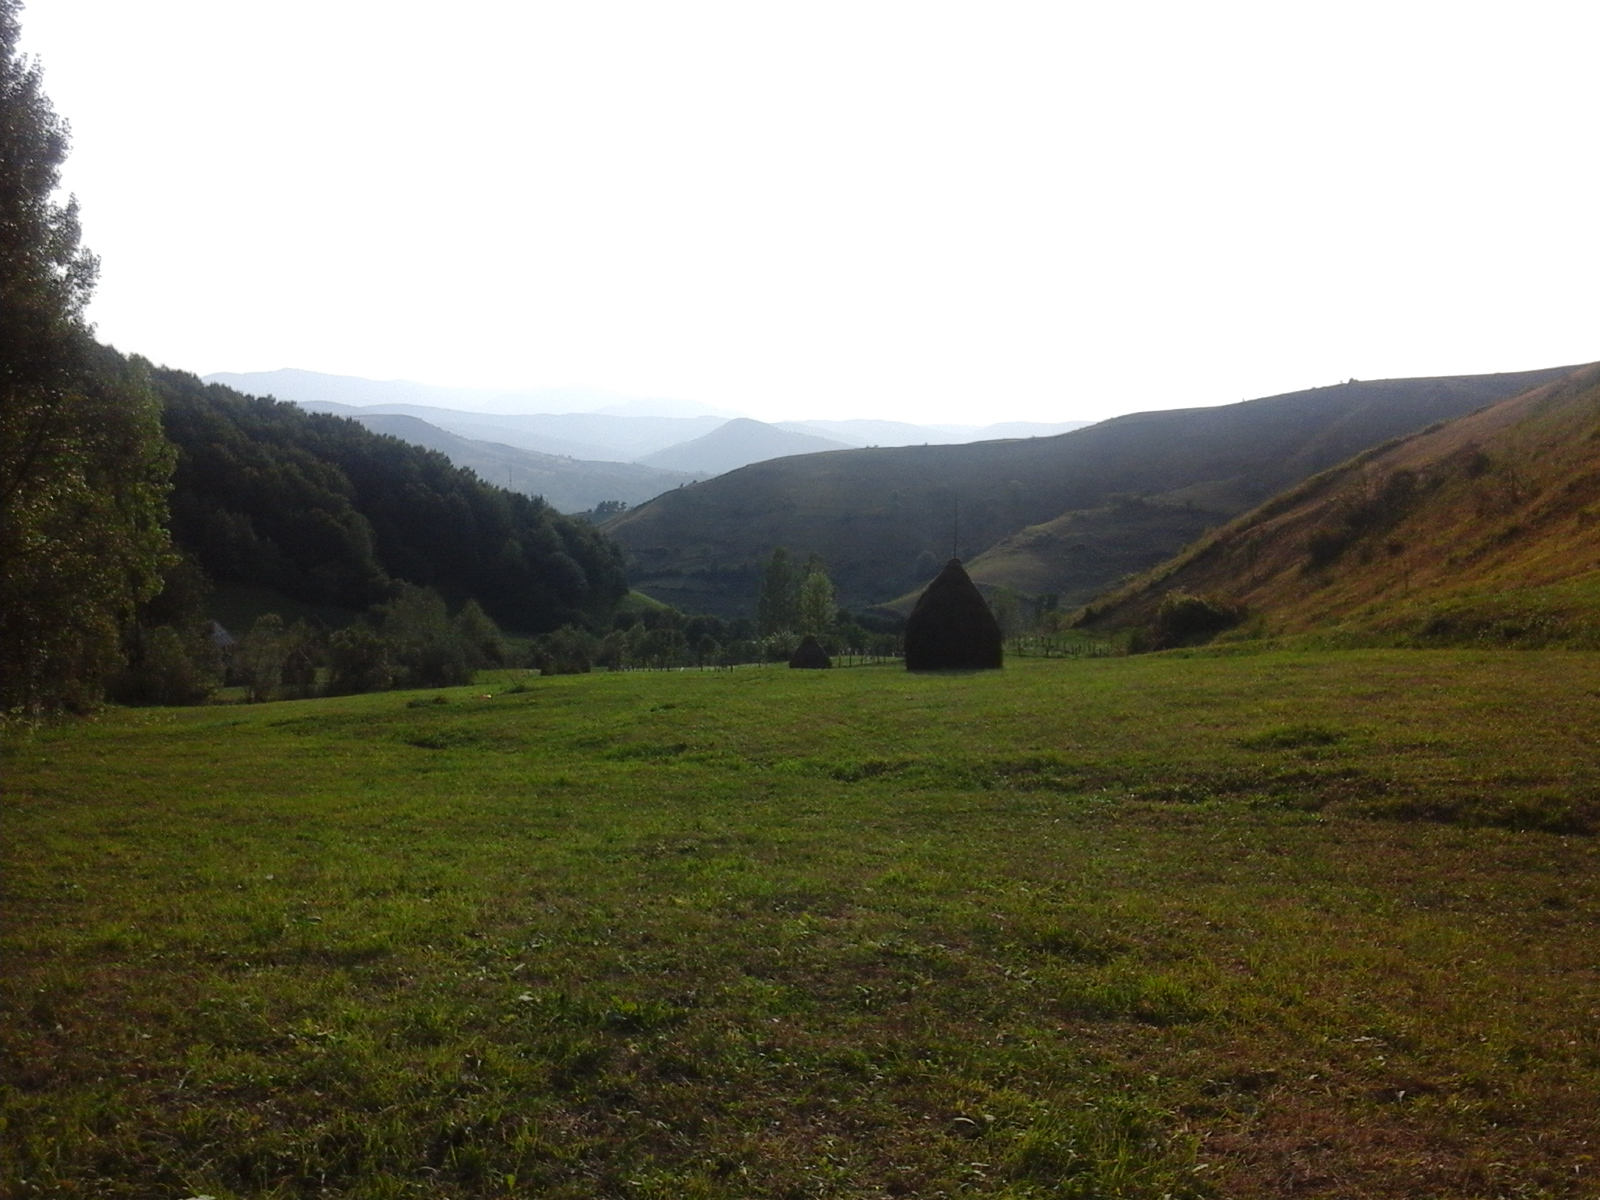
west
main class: Grassland
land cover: Grassland with sparse tree/shrub cover
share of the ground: > 75 %
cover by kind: herbaceous plants 95 %, broadleaved forest trees 5 %
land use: Agriculture (excluding fallow land and kitchen gardens)
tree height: > 5 m
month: September
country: RO
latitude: 47.7497
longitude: 24.2416
